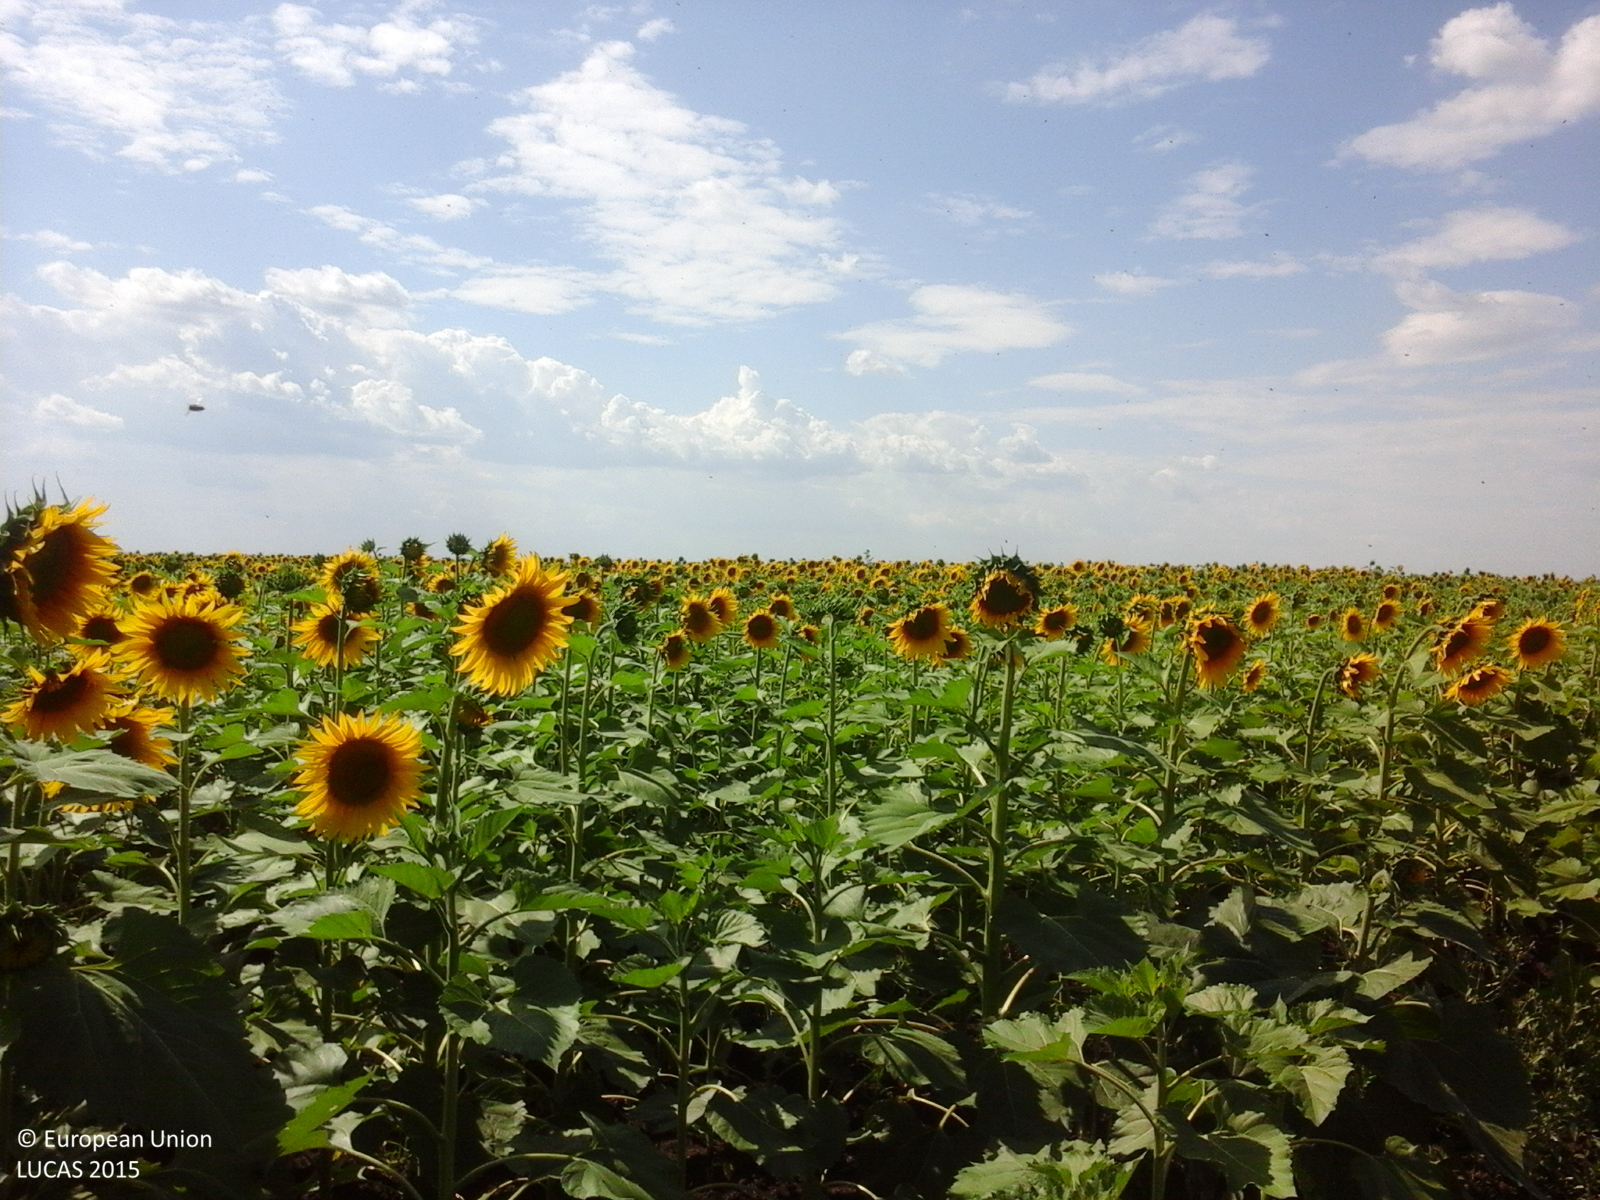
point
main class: Cropland
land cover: Sunflower
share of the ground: > 75 %
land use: Agriculture (excluding fallow land and kitchen gardens)
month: July
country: RO
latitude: 44.0531
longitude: 24.7889
